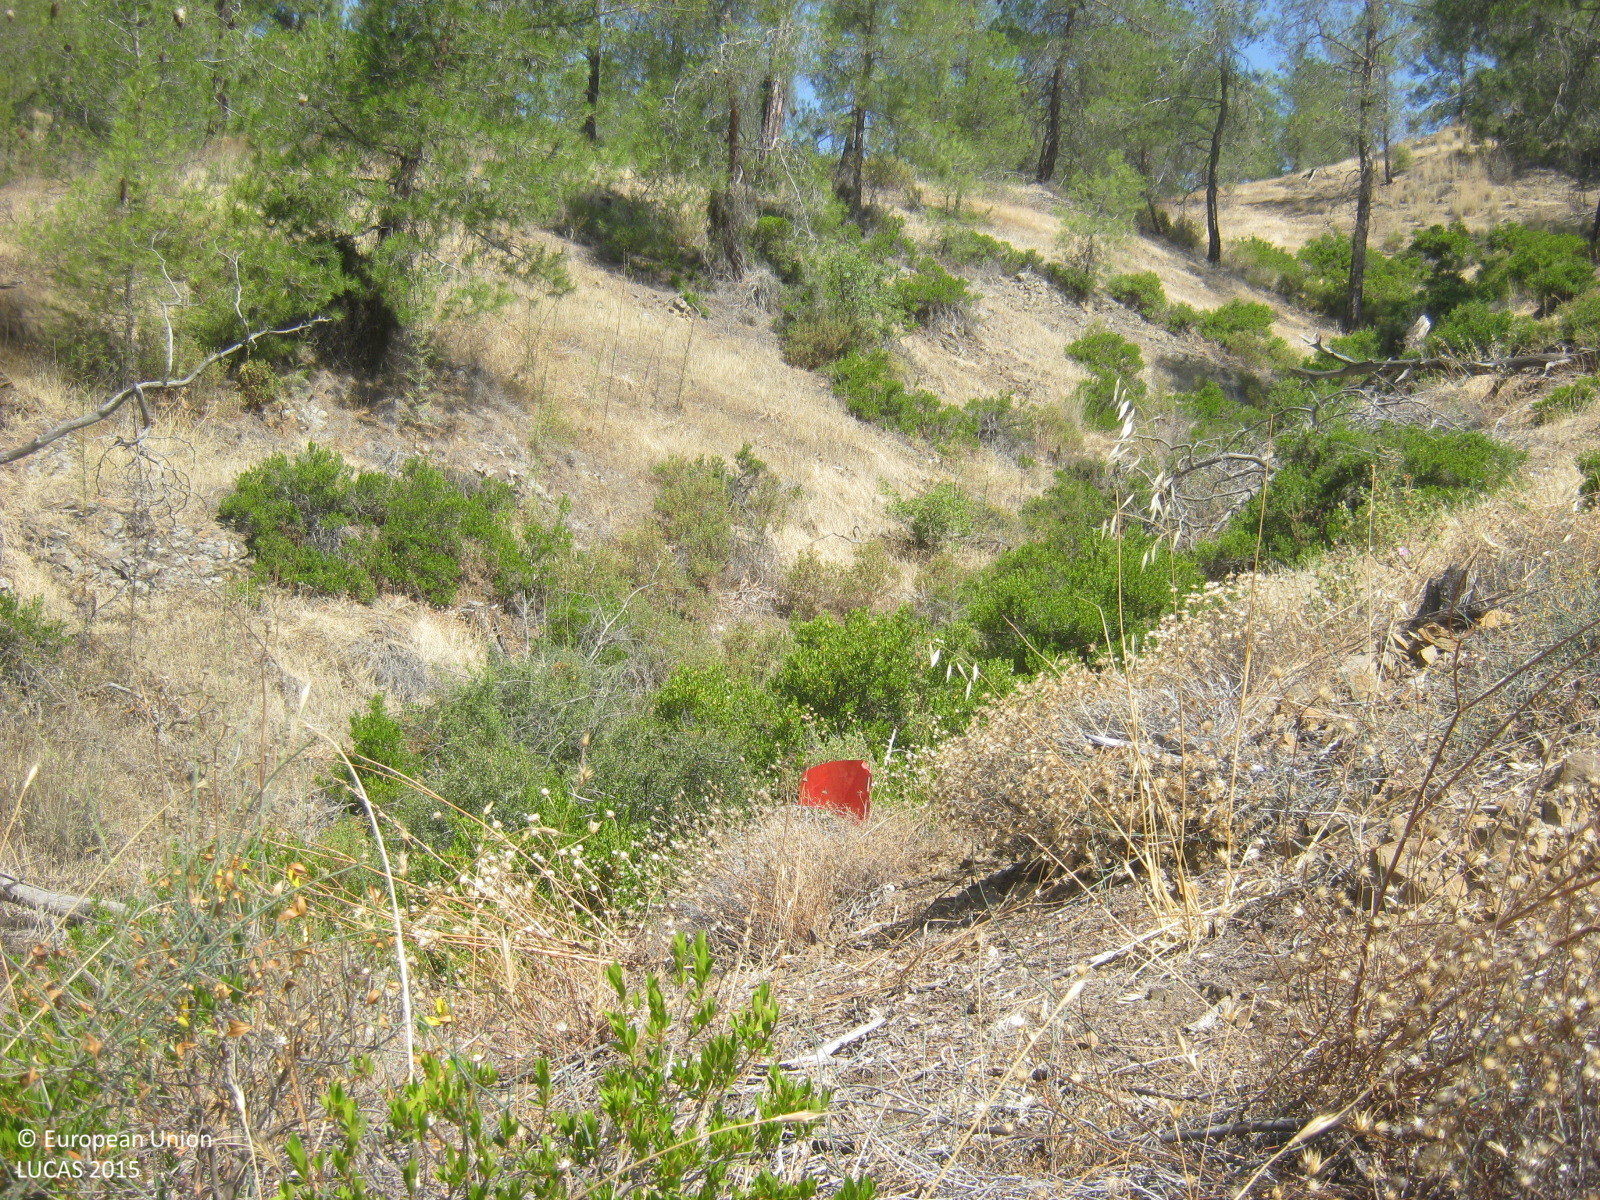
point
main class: Shrubland
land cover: Shrubland with sparse tree cover
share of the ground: 50 - 75 %
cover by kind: shrubs 50 %, herbaceous plants 35 %, unconsolidated bare surface 10 %, coniferous forest trees 5 %
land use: Forestry
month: June
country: CY
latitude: 35.0141
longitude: 33.0925
